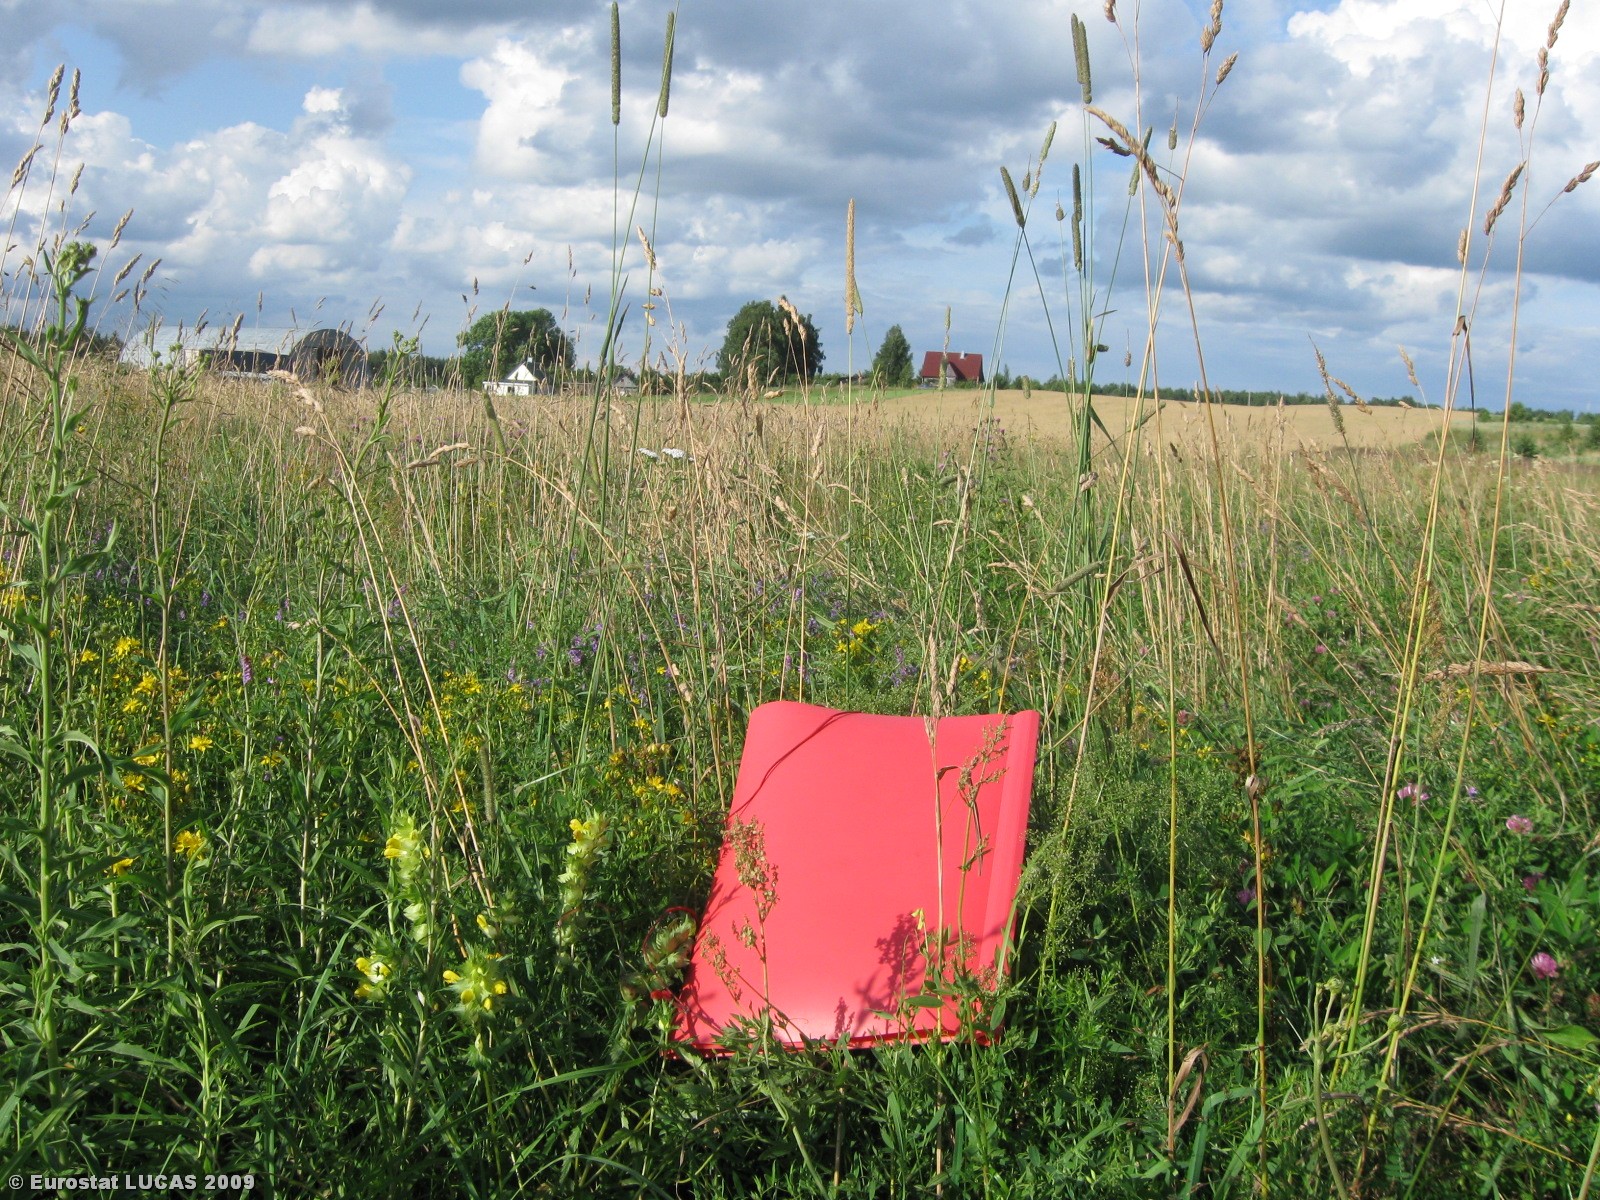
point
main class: Grassland
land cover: Grassland without tree/shrub cover
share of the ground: > 75 %
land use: Agriculture (excluding fallow land and kitchen gardens)
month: July
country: LT
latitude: 54.4885
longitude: 25.3285
